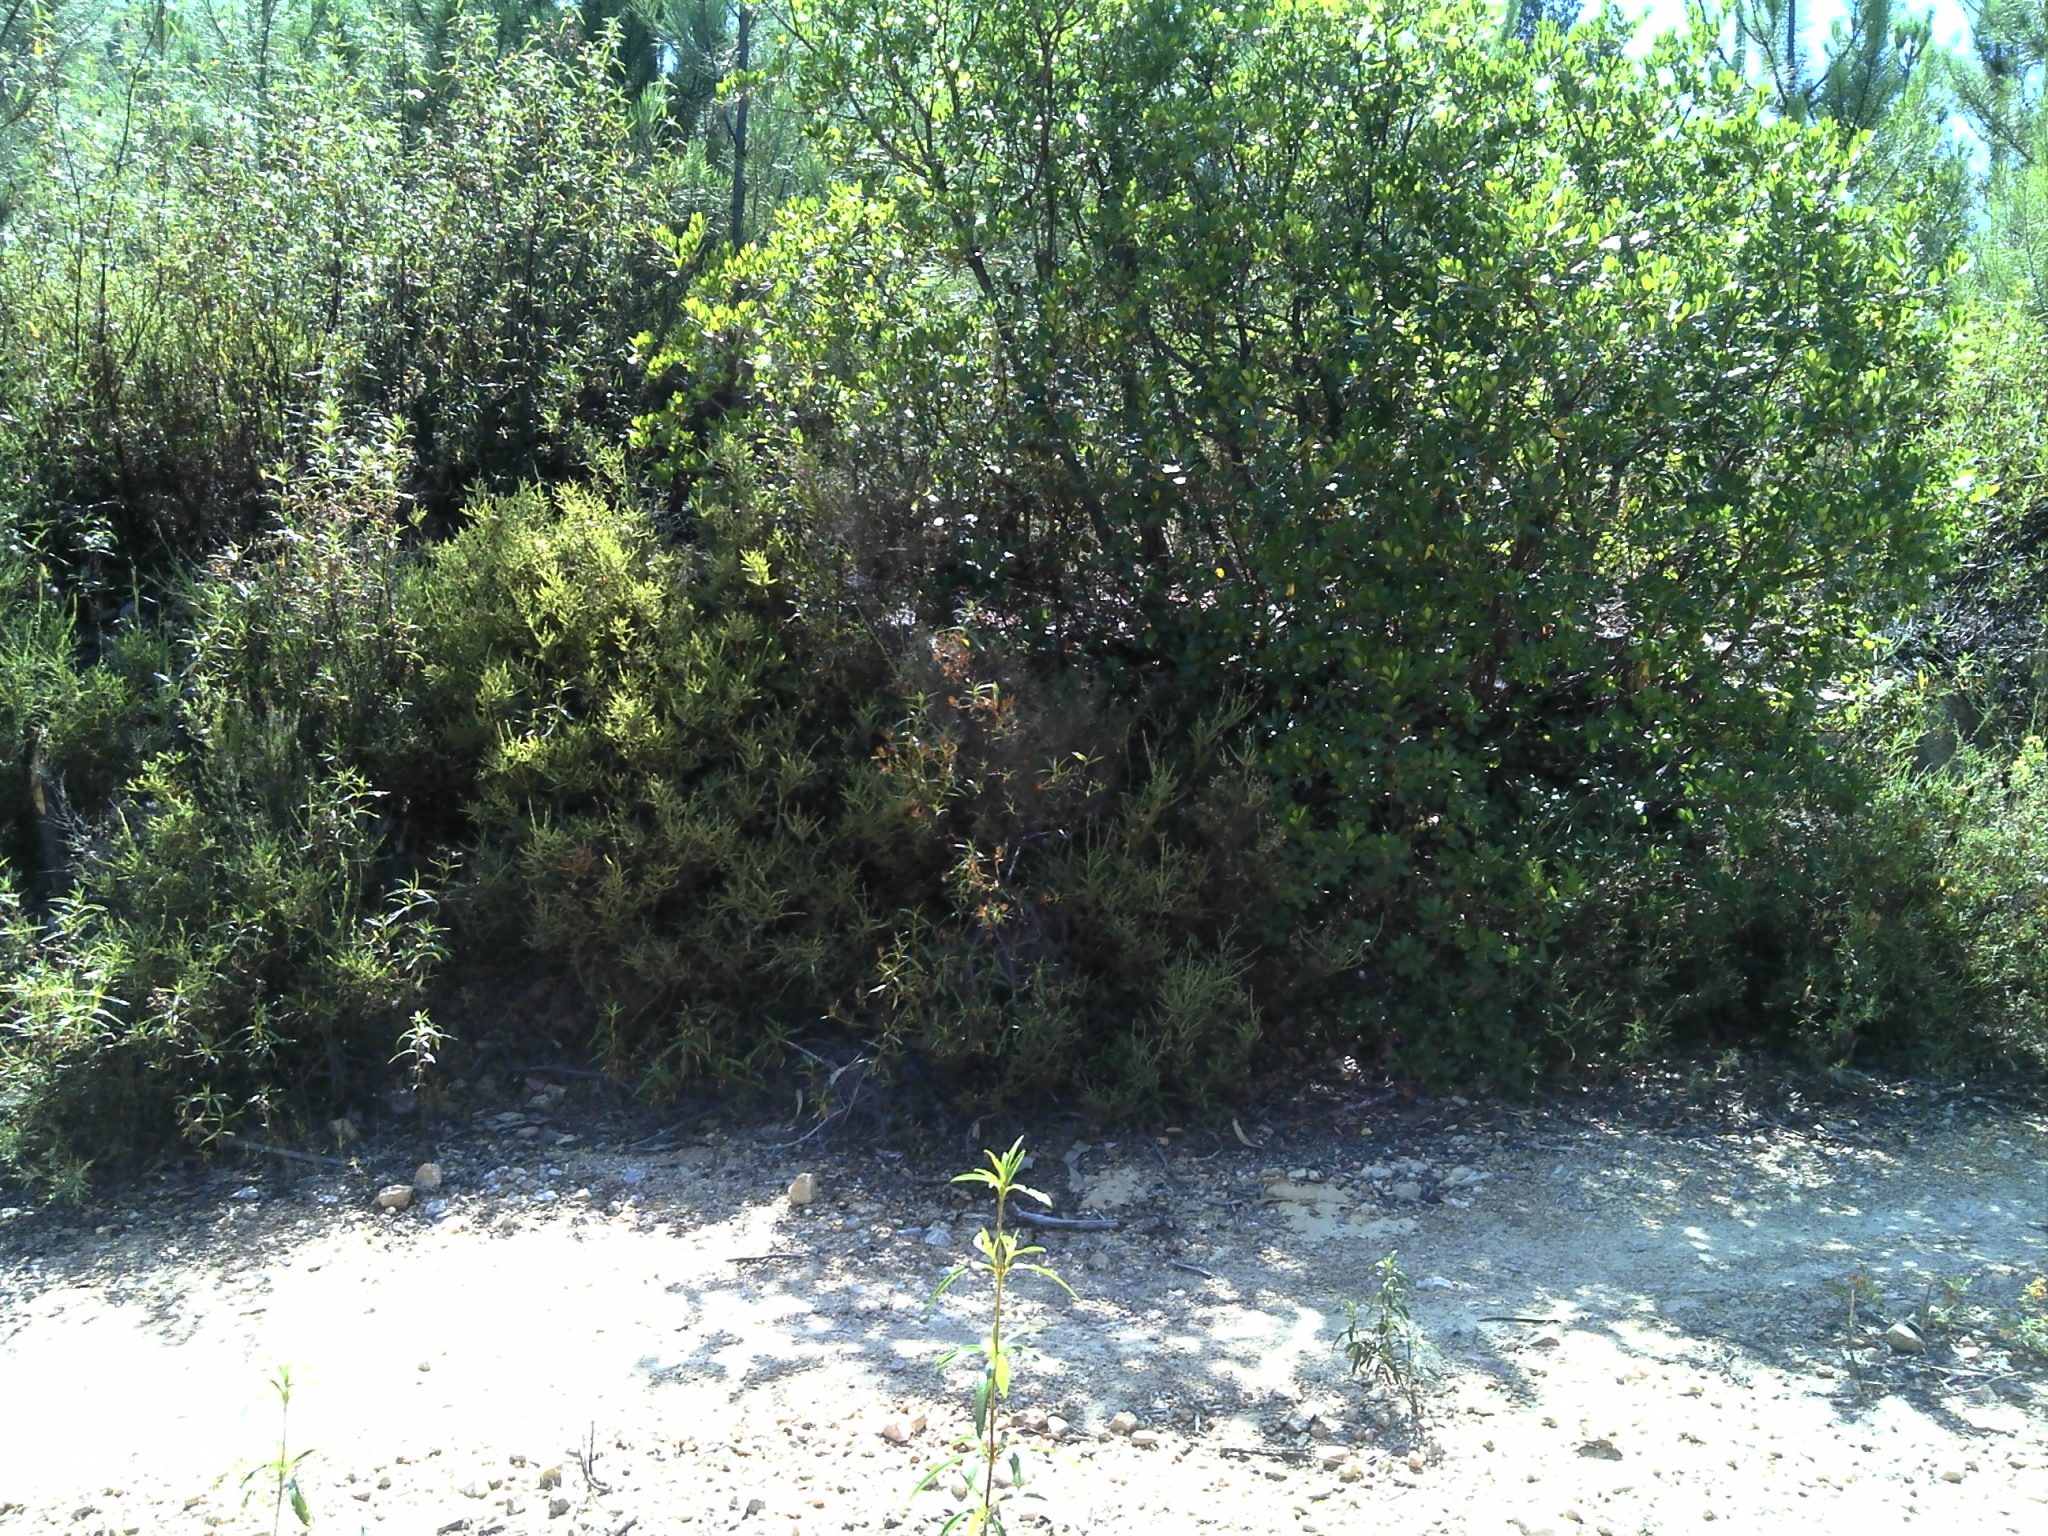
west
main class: Woodland
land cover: Pine dominated mixed woodland
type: coniferous forest of the mediterranean region
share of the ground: 25 - 50 %
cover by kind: shrubs 60 %, coniferous forest trees 15 %, broadleaved forest trees 10 %, unconsolidated bare surface 10 %, consolidated bare surface 5 %
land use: Forestry
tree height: > 5 m
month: July
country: PT
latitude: 39.8066
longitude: -7.8022
